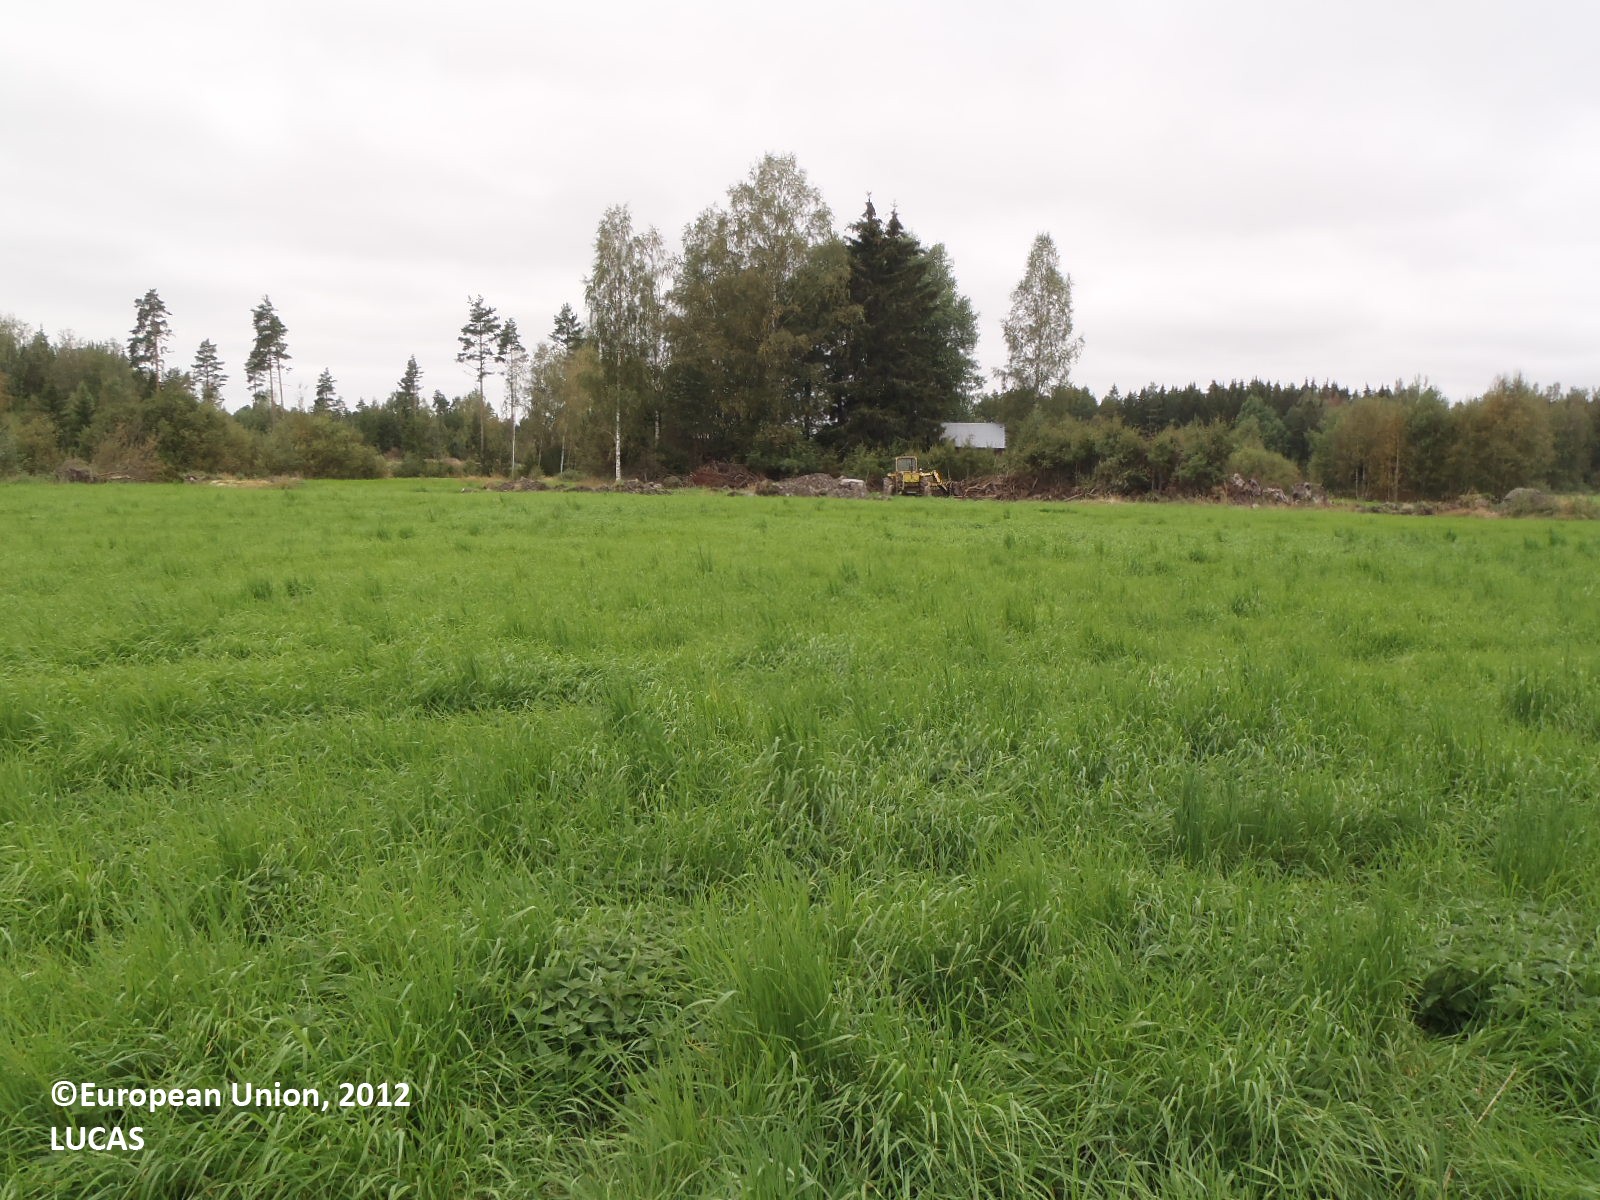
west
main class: Cropland
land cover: Temporary grasslands
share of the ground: > 75 %
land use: Agriculture (excluding fallow land and kitchen gardens)
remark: Harvested field
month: August
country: FI
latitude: 60.8046
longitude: 21.9139
